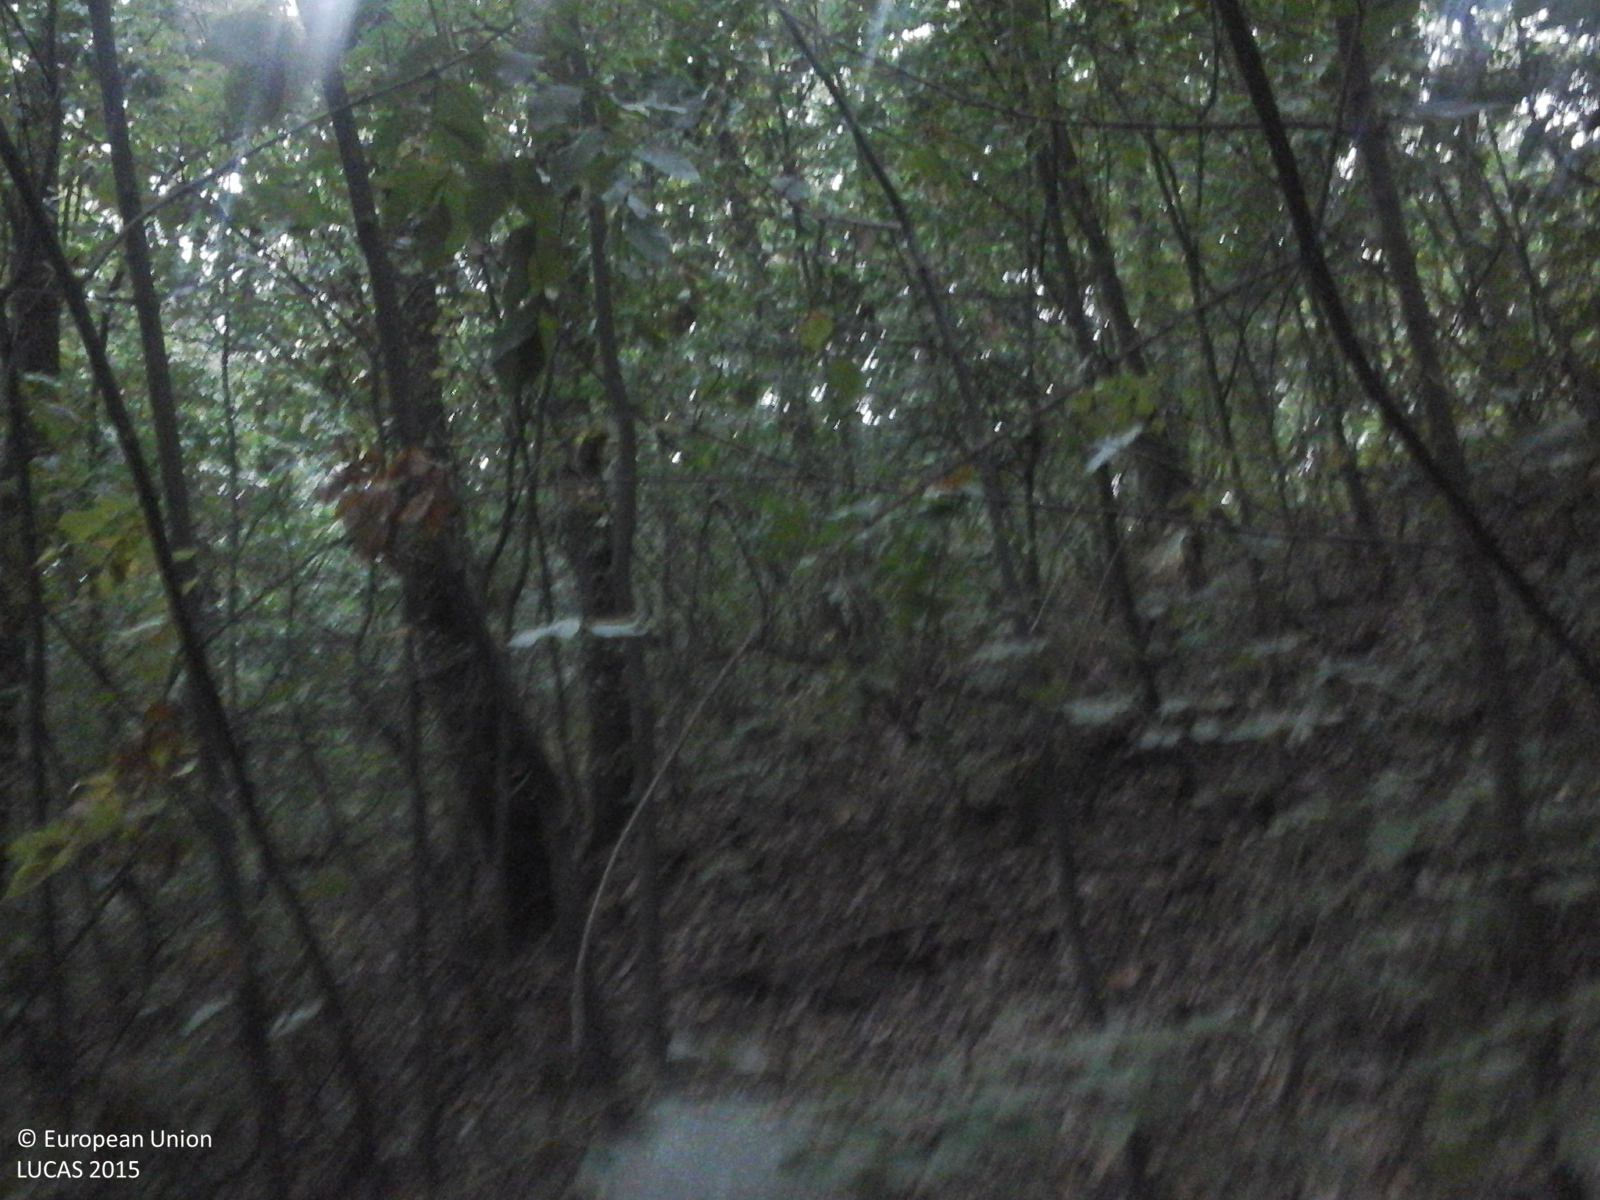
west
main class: Woodland
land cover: Broadleaved woodland
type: acidophilous oak and oak-birch forest
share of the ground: > 75 %
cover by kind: broadleaved forest trees 100 %
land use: Forestry
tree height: > 5 m
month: September
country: RO
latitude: 44.7319
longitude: 23.2978
